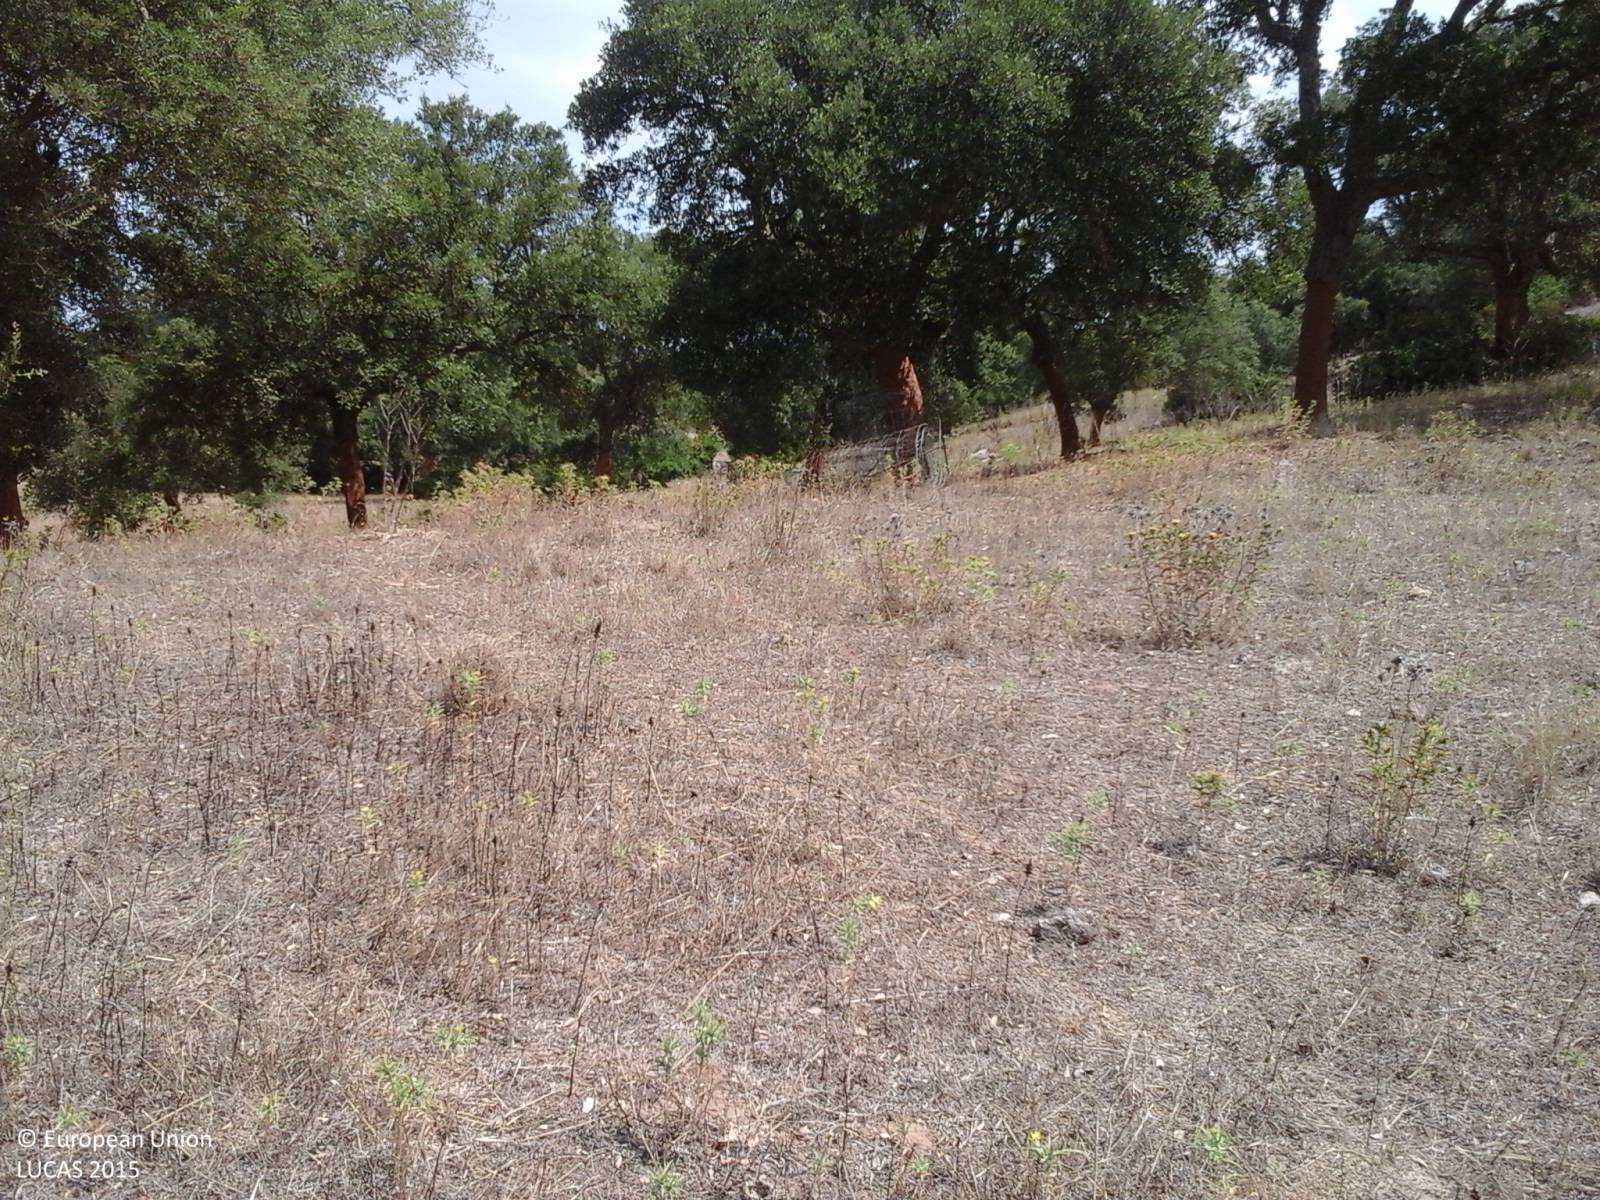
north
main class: Woodland
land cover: Broadleaved woodland
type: thermophilous deciduous forest
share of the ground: 25 - 50 %
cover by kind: broadleaved forest trees 65 %, shrubs 35 %
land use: Forestry
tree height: < 5 m
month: July
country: IT
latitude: 39.9895
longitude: 8.8935
